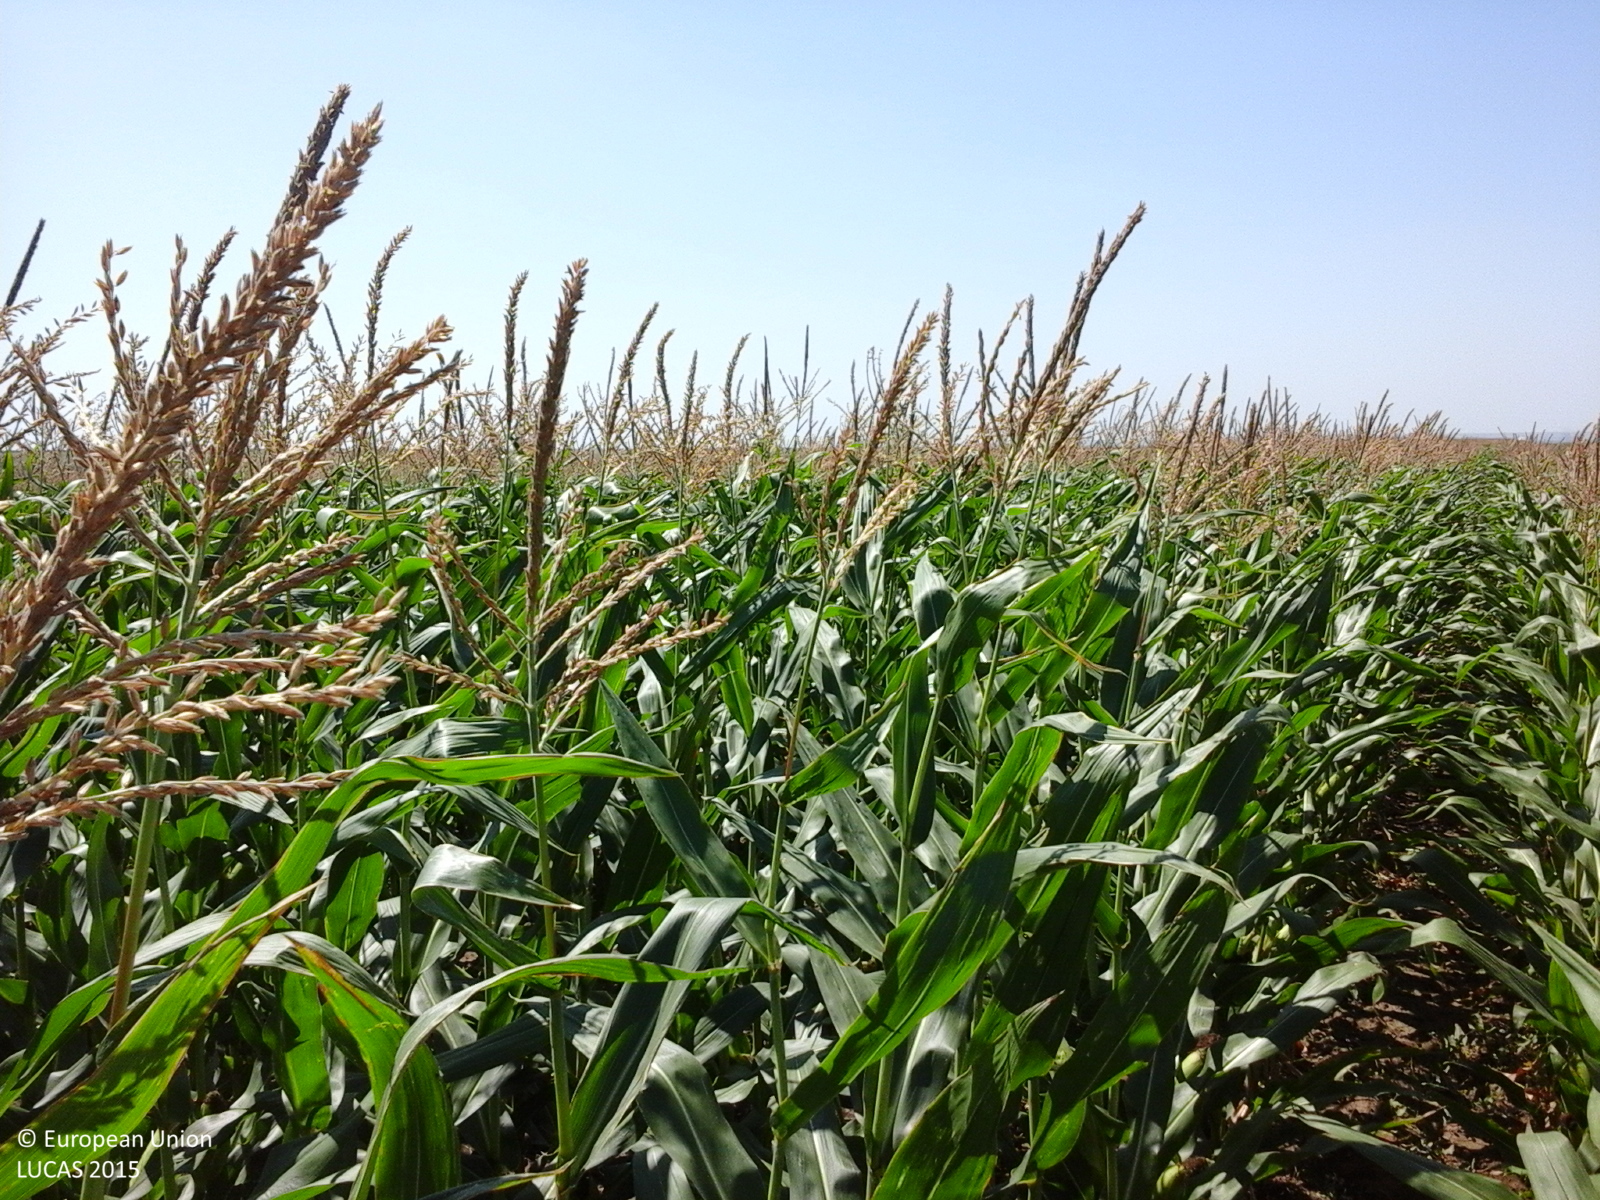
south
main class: Cropland
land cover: Maize
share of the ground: > 75 %
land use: Agriculture (excluding fallow land and kitchen gardens)
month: August
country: RO
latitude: 44.3499
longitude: 28.3962
